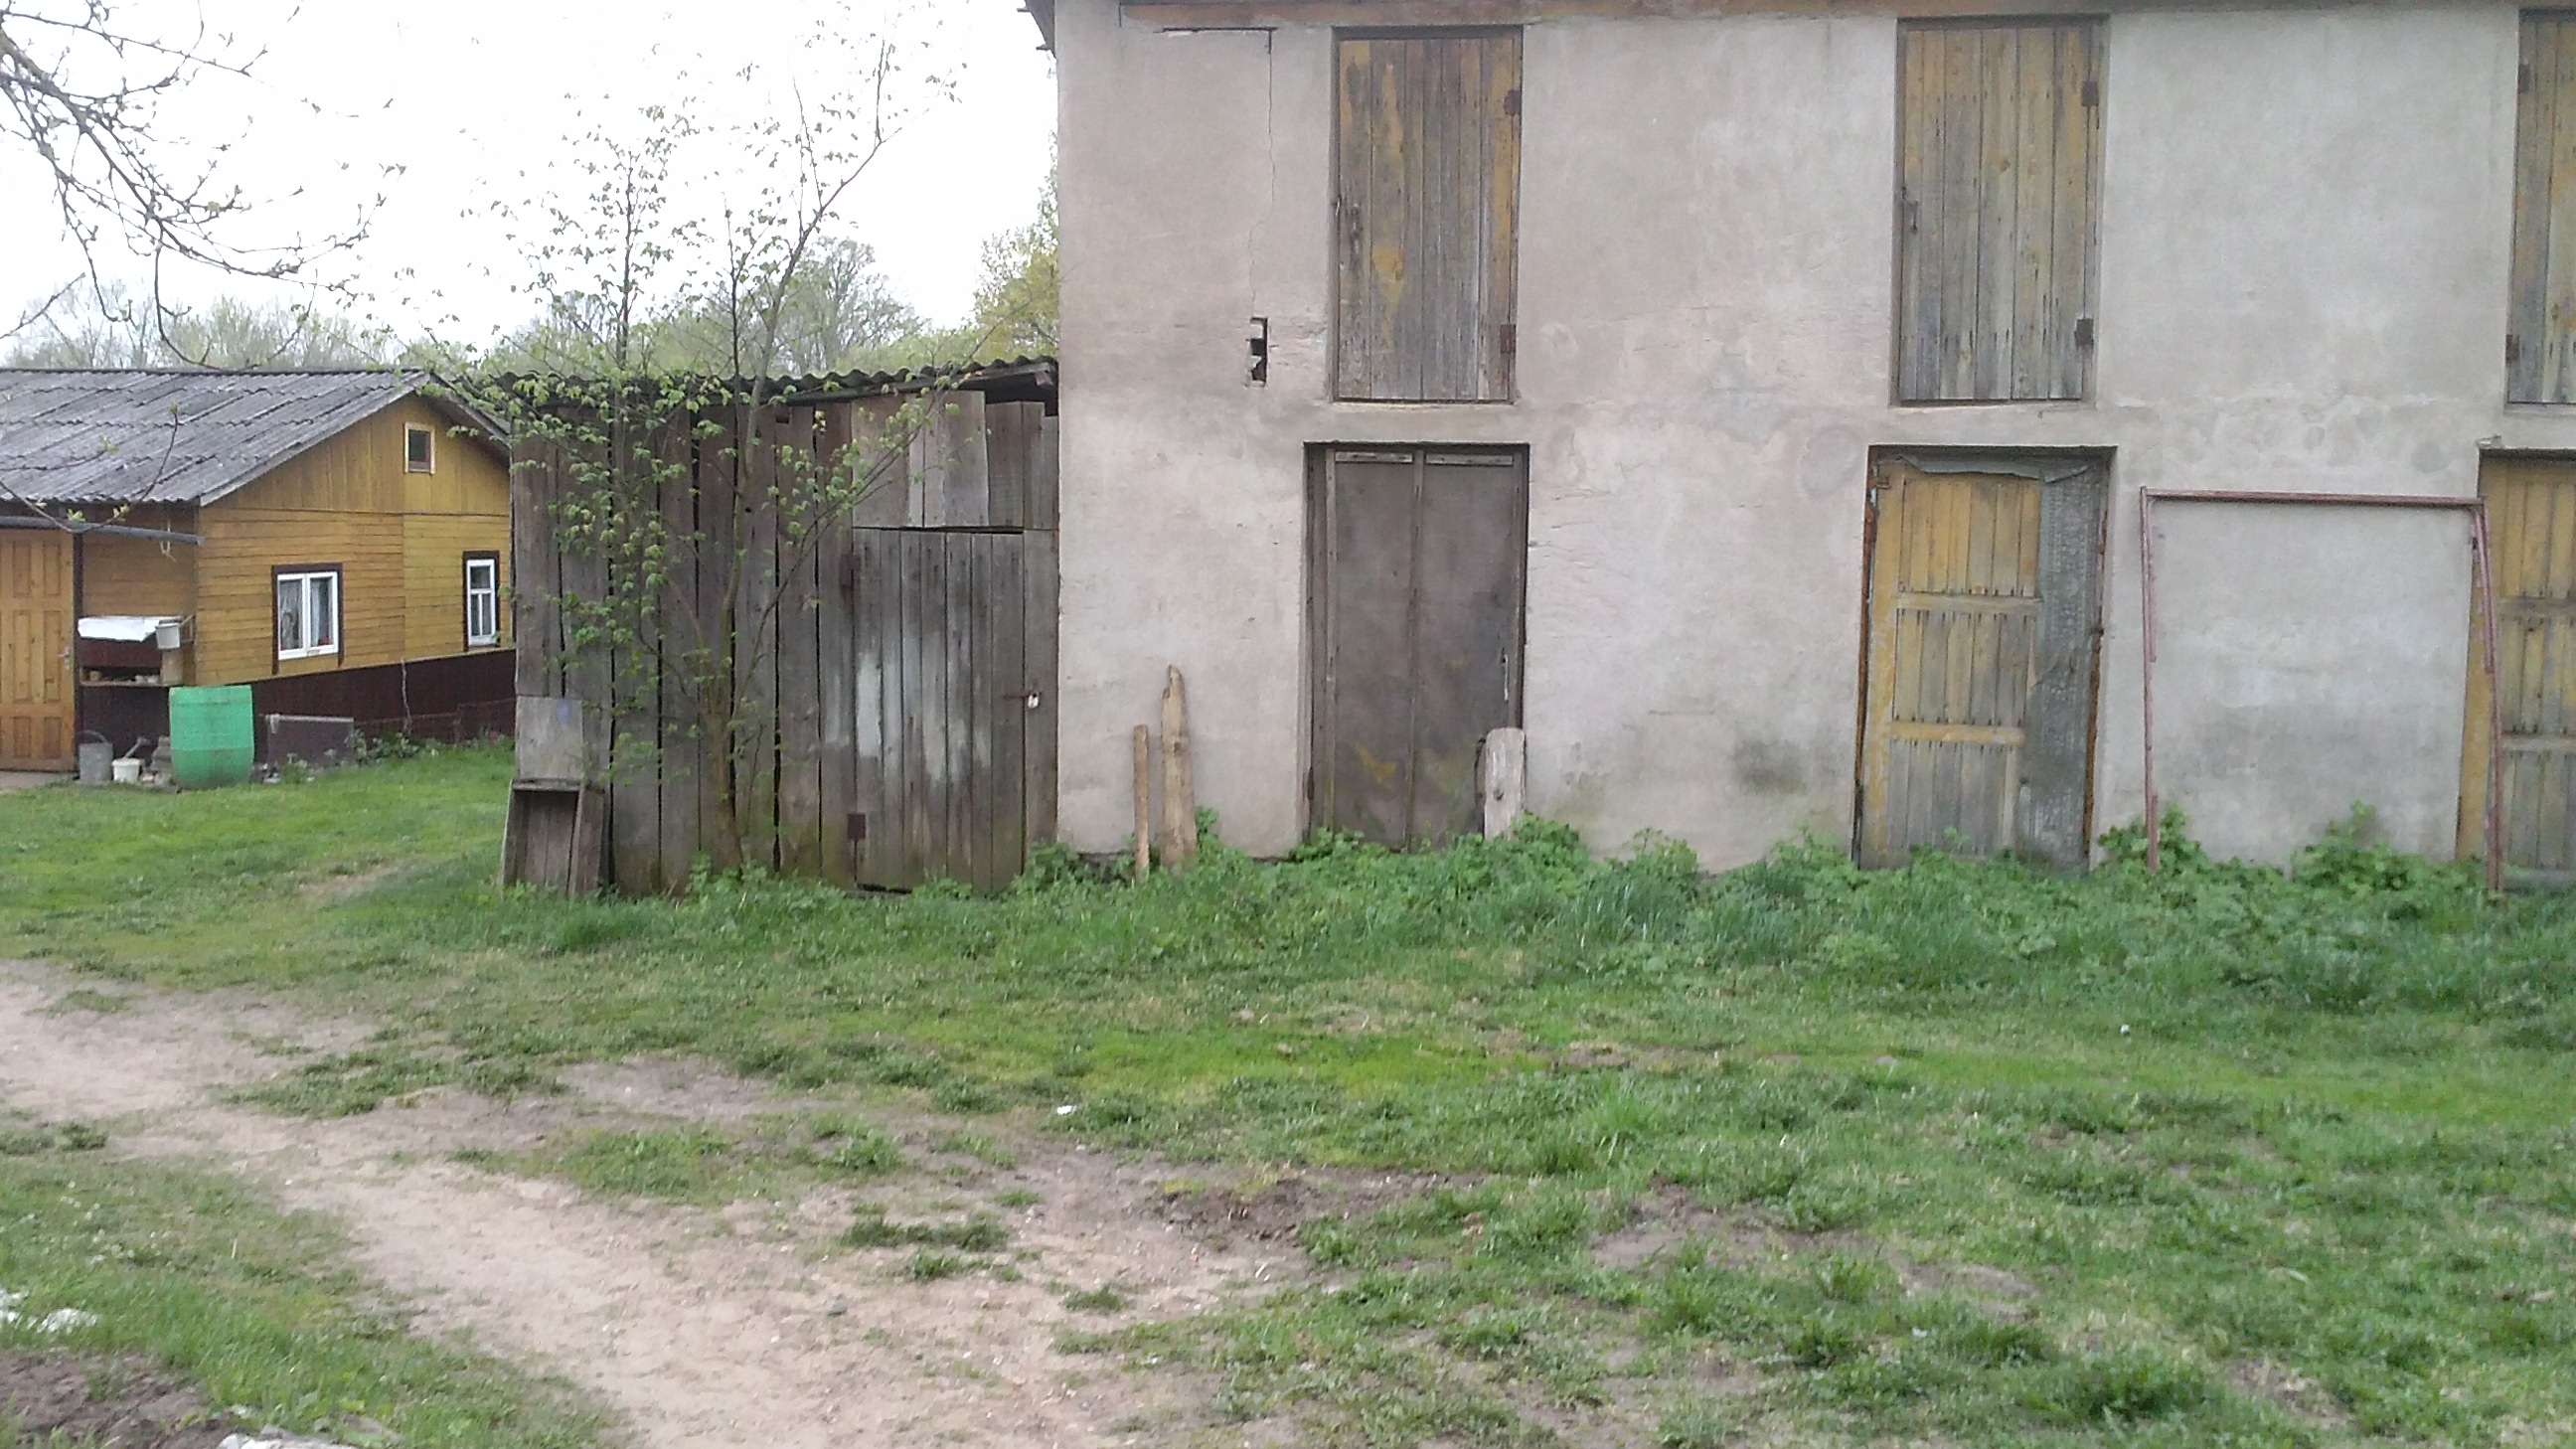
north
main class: Cropland
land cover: Floriculture and ornamental plants
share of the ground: > 75 %
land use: Kitchen garden
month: May
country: LV
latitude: 55.9231
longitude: 27.1496
